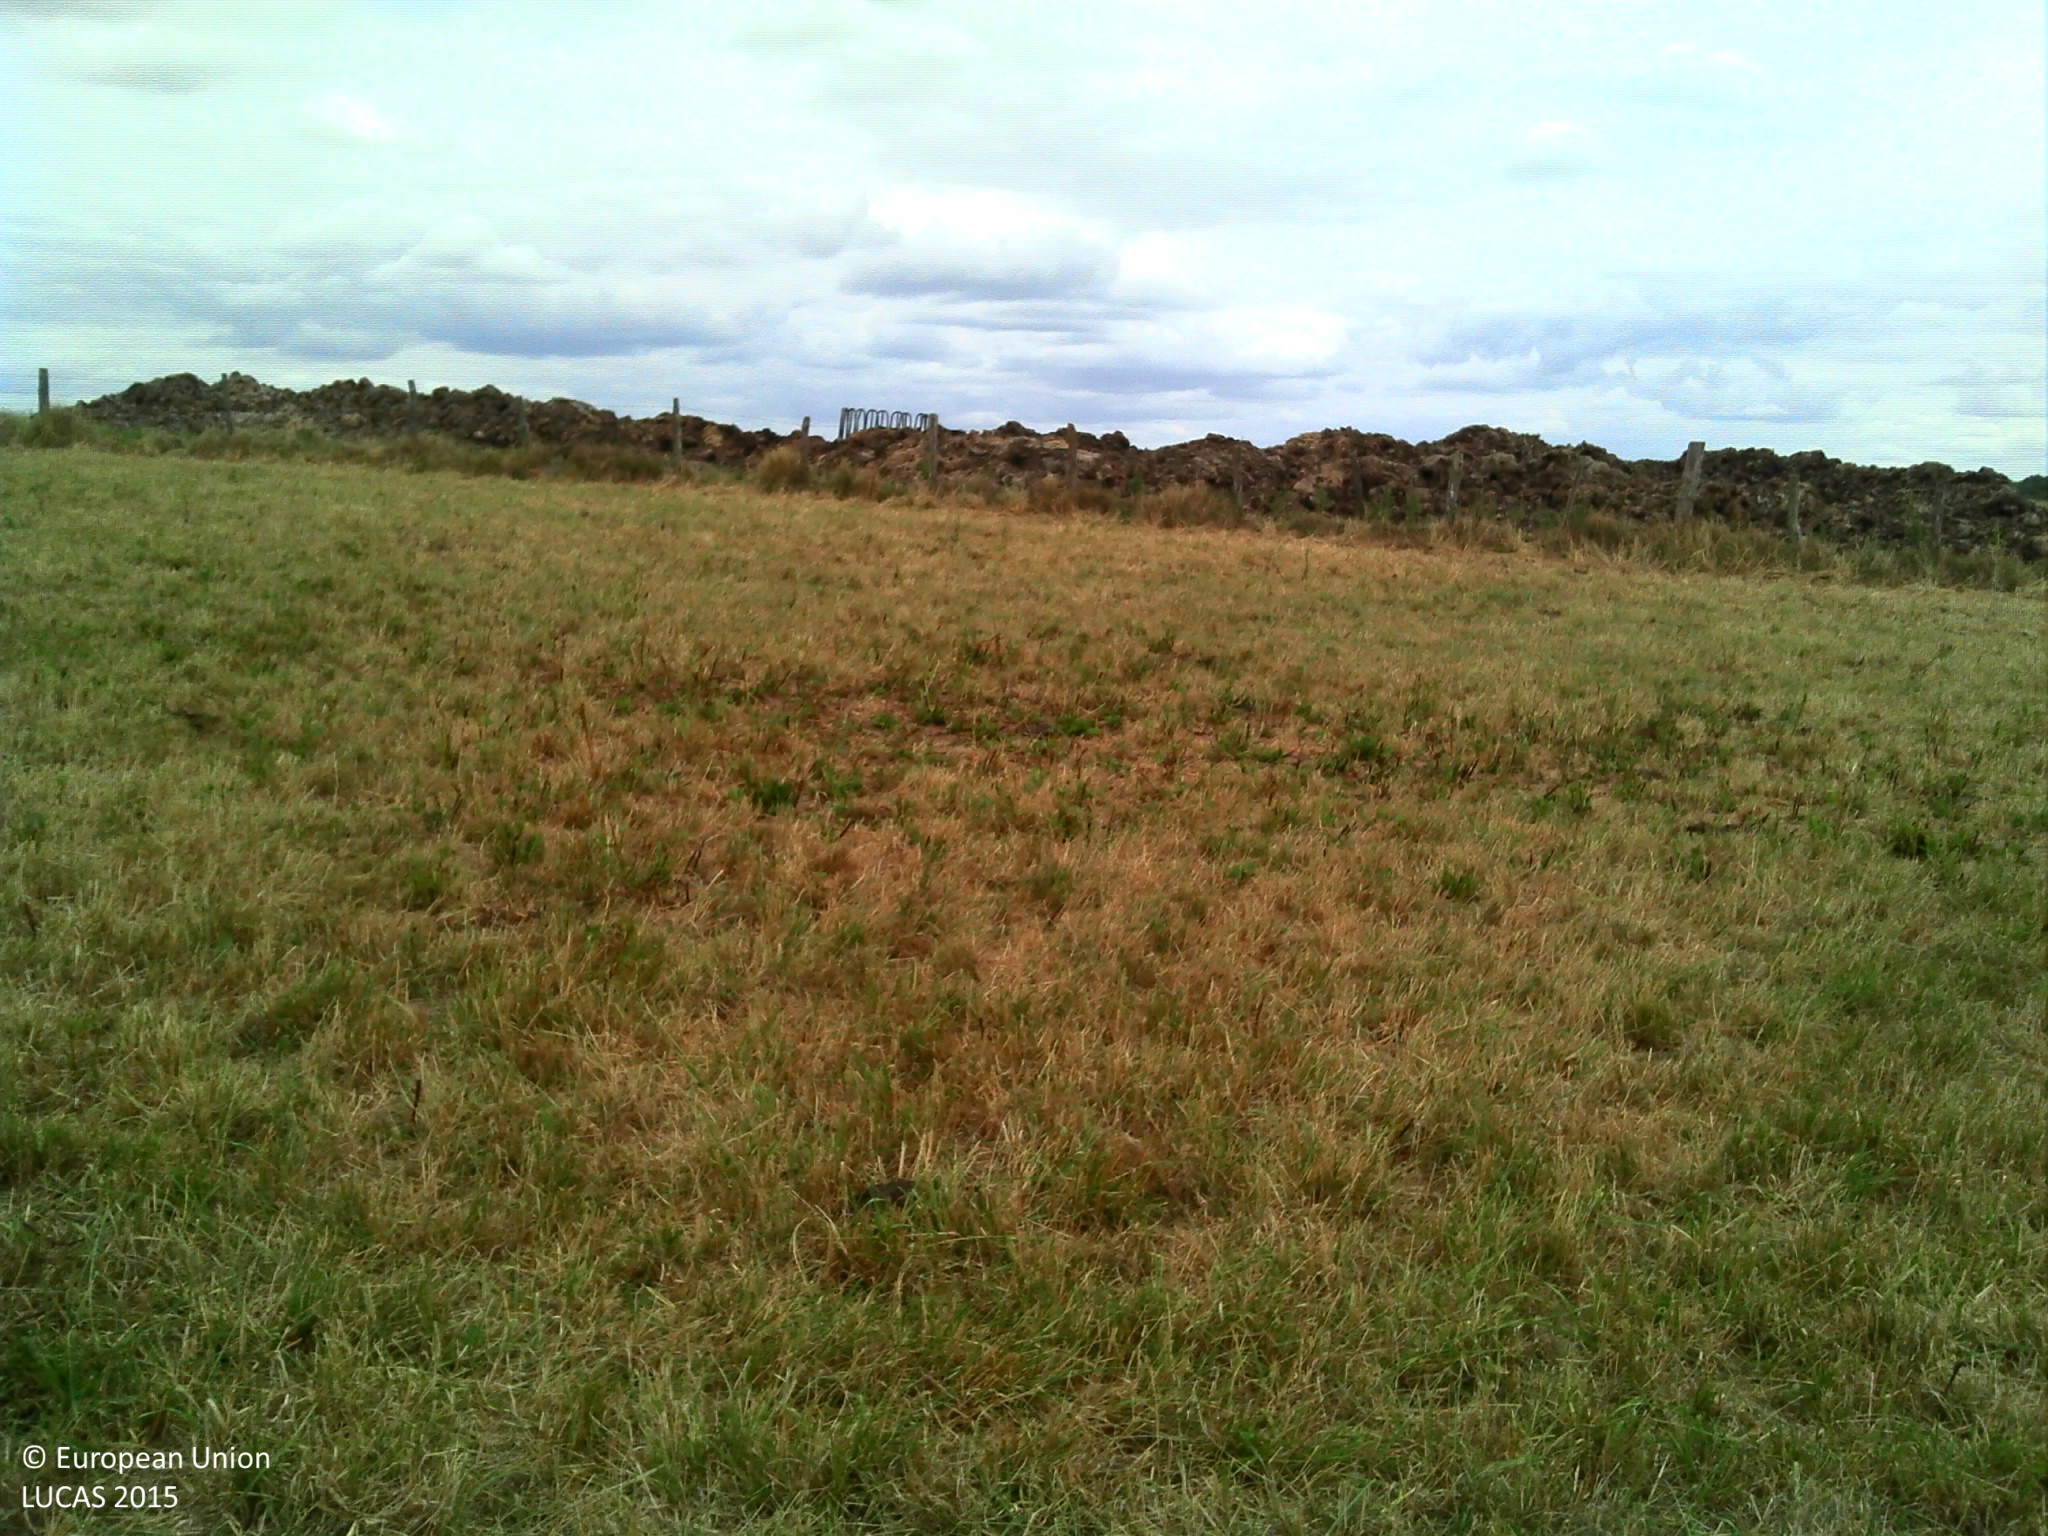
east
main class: Grassland
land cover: Grassland without tree/shrub cover
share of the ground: > 75 %
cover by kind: herbaceous plants 100 %
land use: Agriculture (excluding fallow land and kitchen gardens)
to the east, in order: Grassland without tree/shrub cover; Fences; Grassland without tree/shrub cover
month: July
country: FR
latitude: 46.8389
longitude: 3.1918
